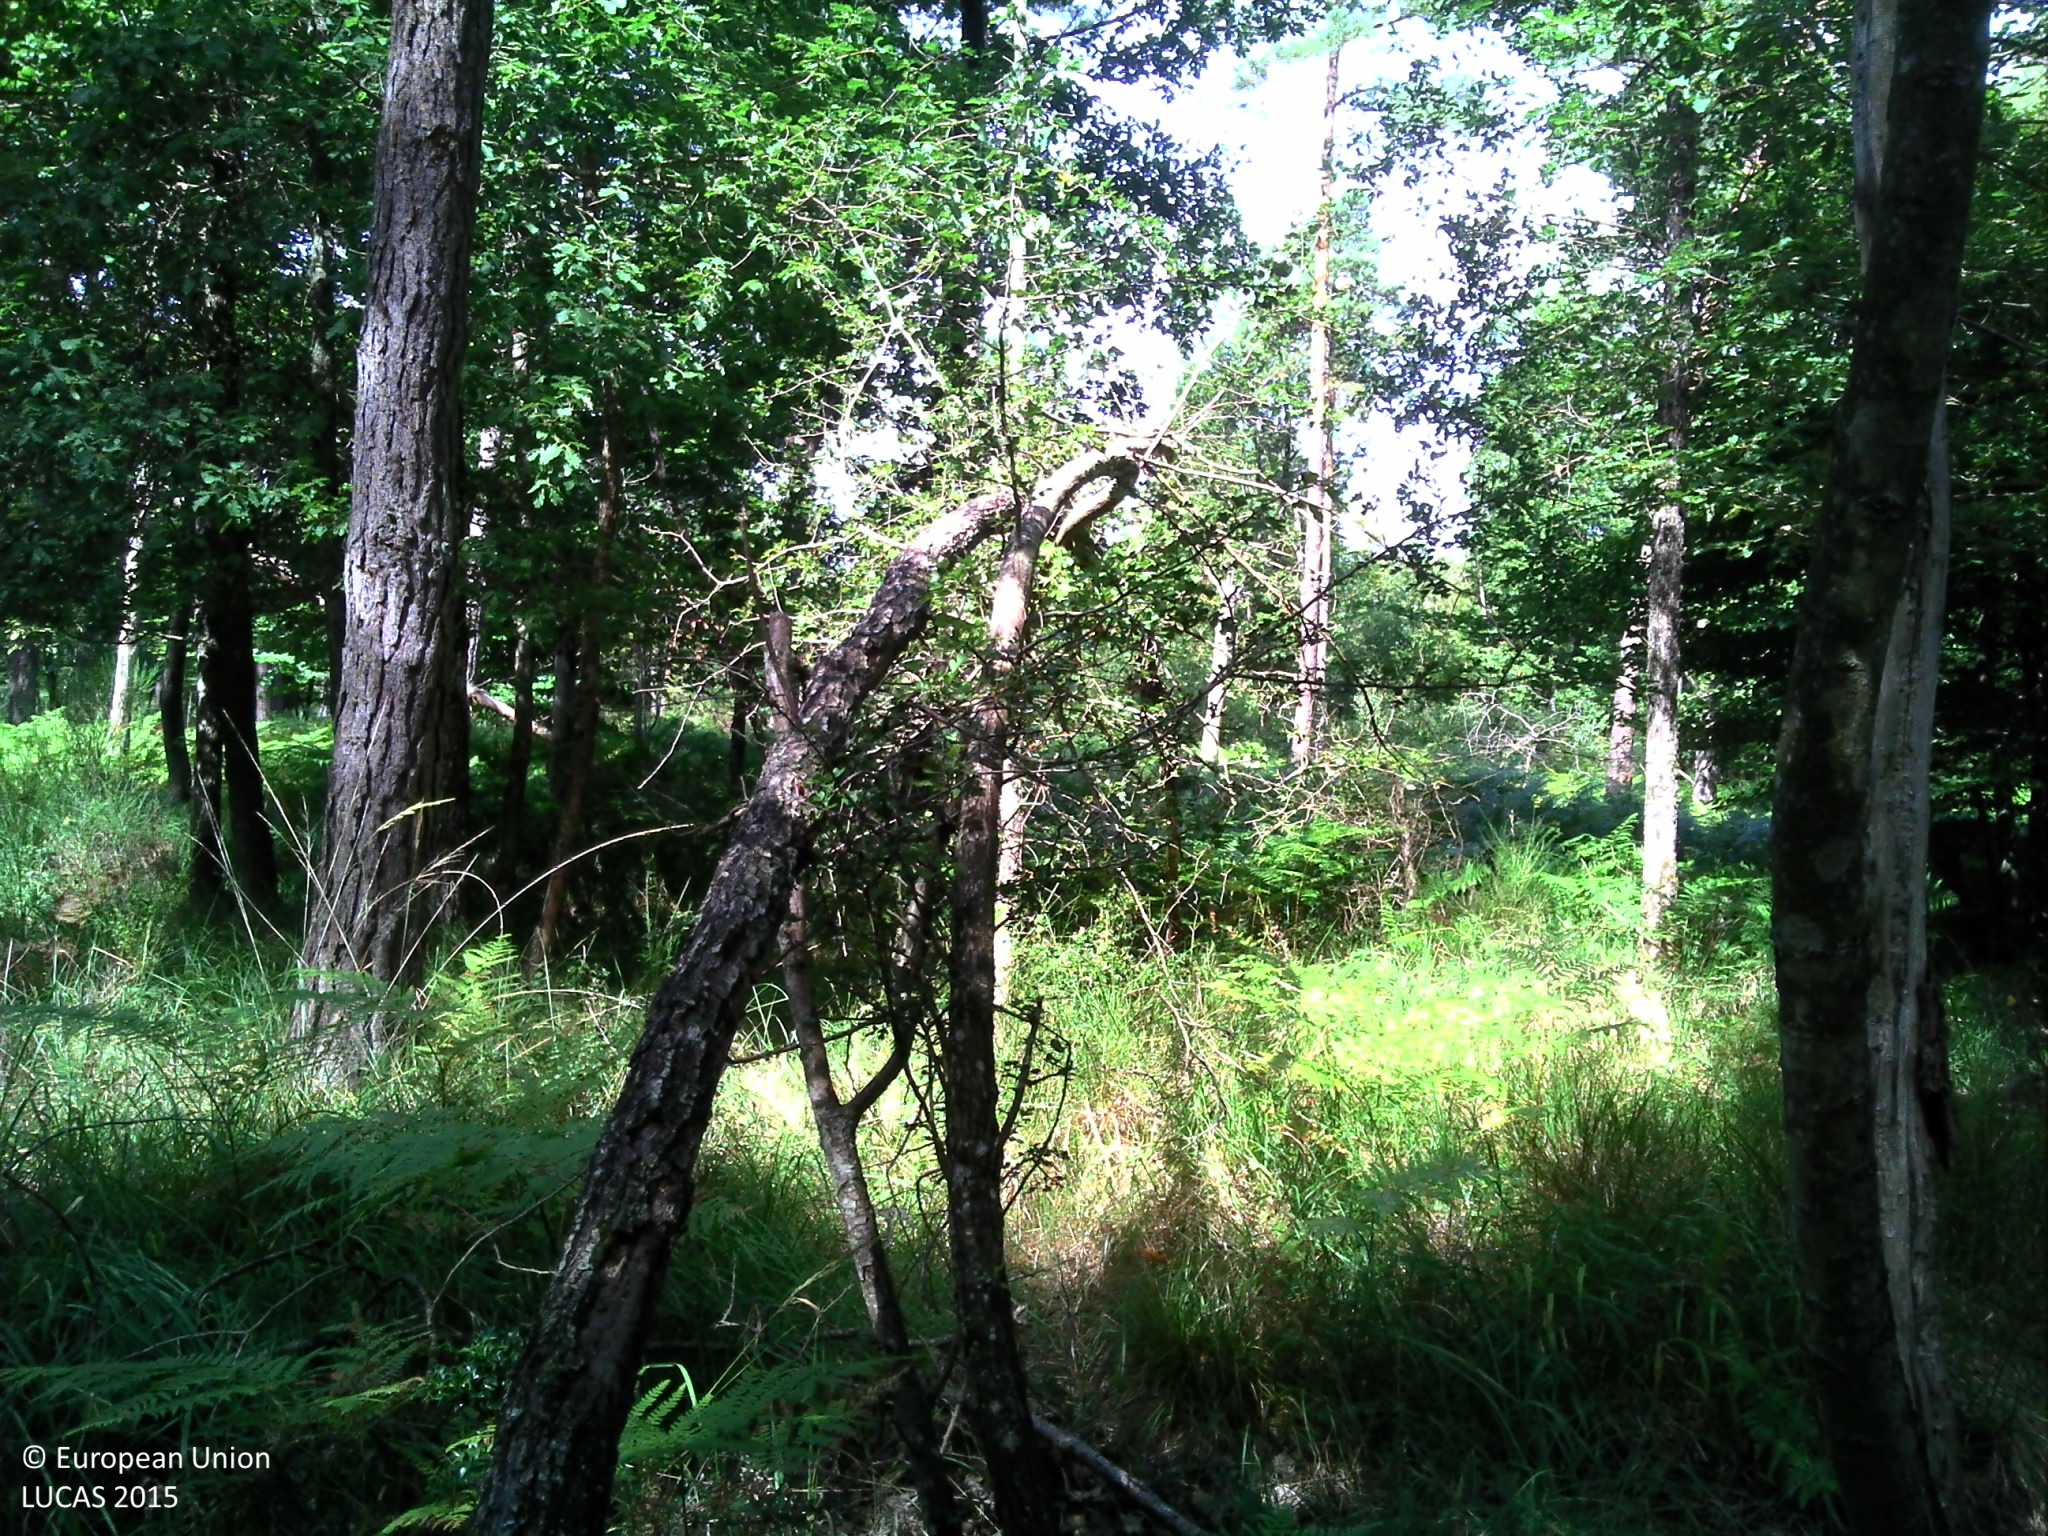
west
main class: Woodland
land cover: Pine dominated mixed woodland
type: hemiboreal forest and nemoral coniferous forest and mixed broadleaved-coniferous forest
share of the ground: > 75 %
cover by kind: herbaceous plants 45 %, broadleaved forest trees 30 %, coniferous forest trees 25 %
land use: Forestry
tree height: > 5 m
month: August
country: FR
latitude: 48.3797
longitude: 2.7132
